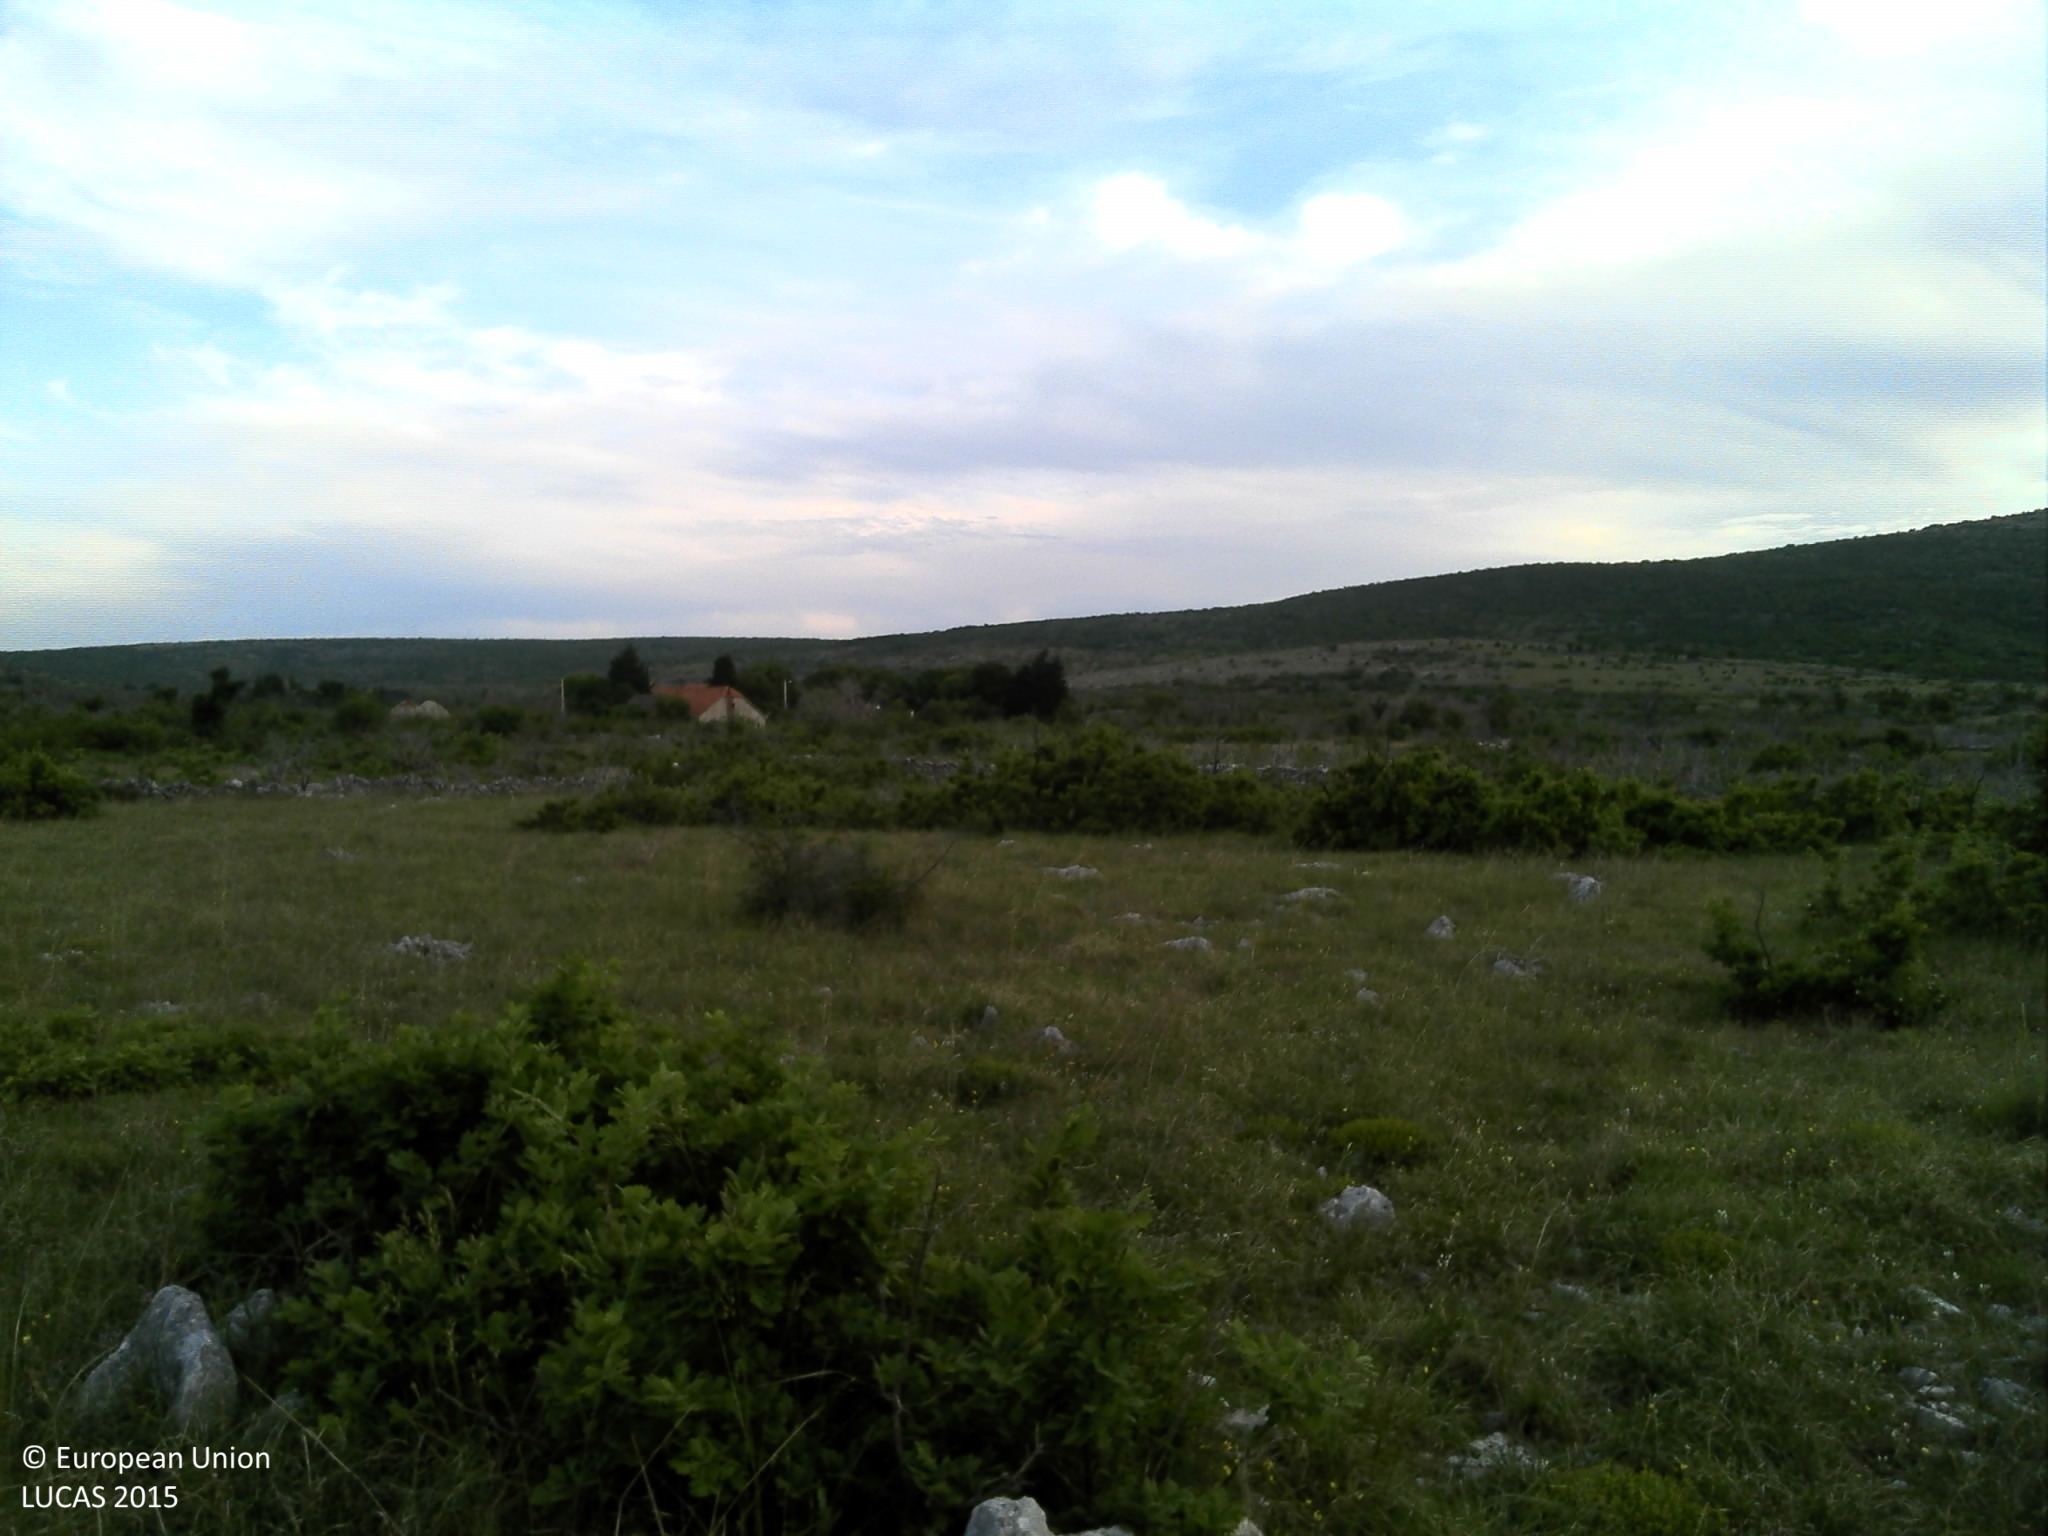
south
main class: Shrubland
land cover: Shrubland with sparse tree cover
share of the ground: 10 - 25 %
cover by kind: herbaceous plants 70 %, shrubs 15 %, broadleaved forest trees 5 %, consolidated bare surface 5 %, unconsolidated bare surface 5 %
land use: Semi-natural and natural areas not in use
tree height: < 5 m
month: May
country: HR
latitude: 43.7601
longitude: 16.0154
